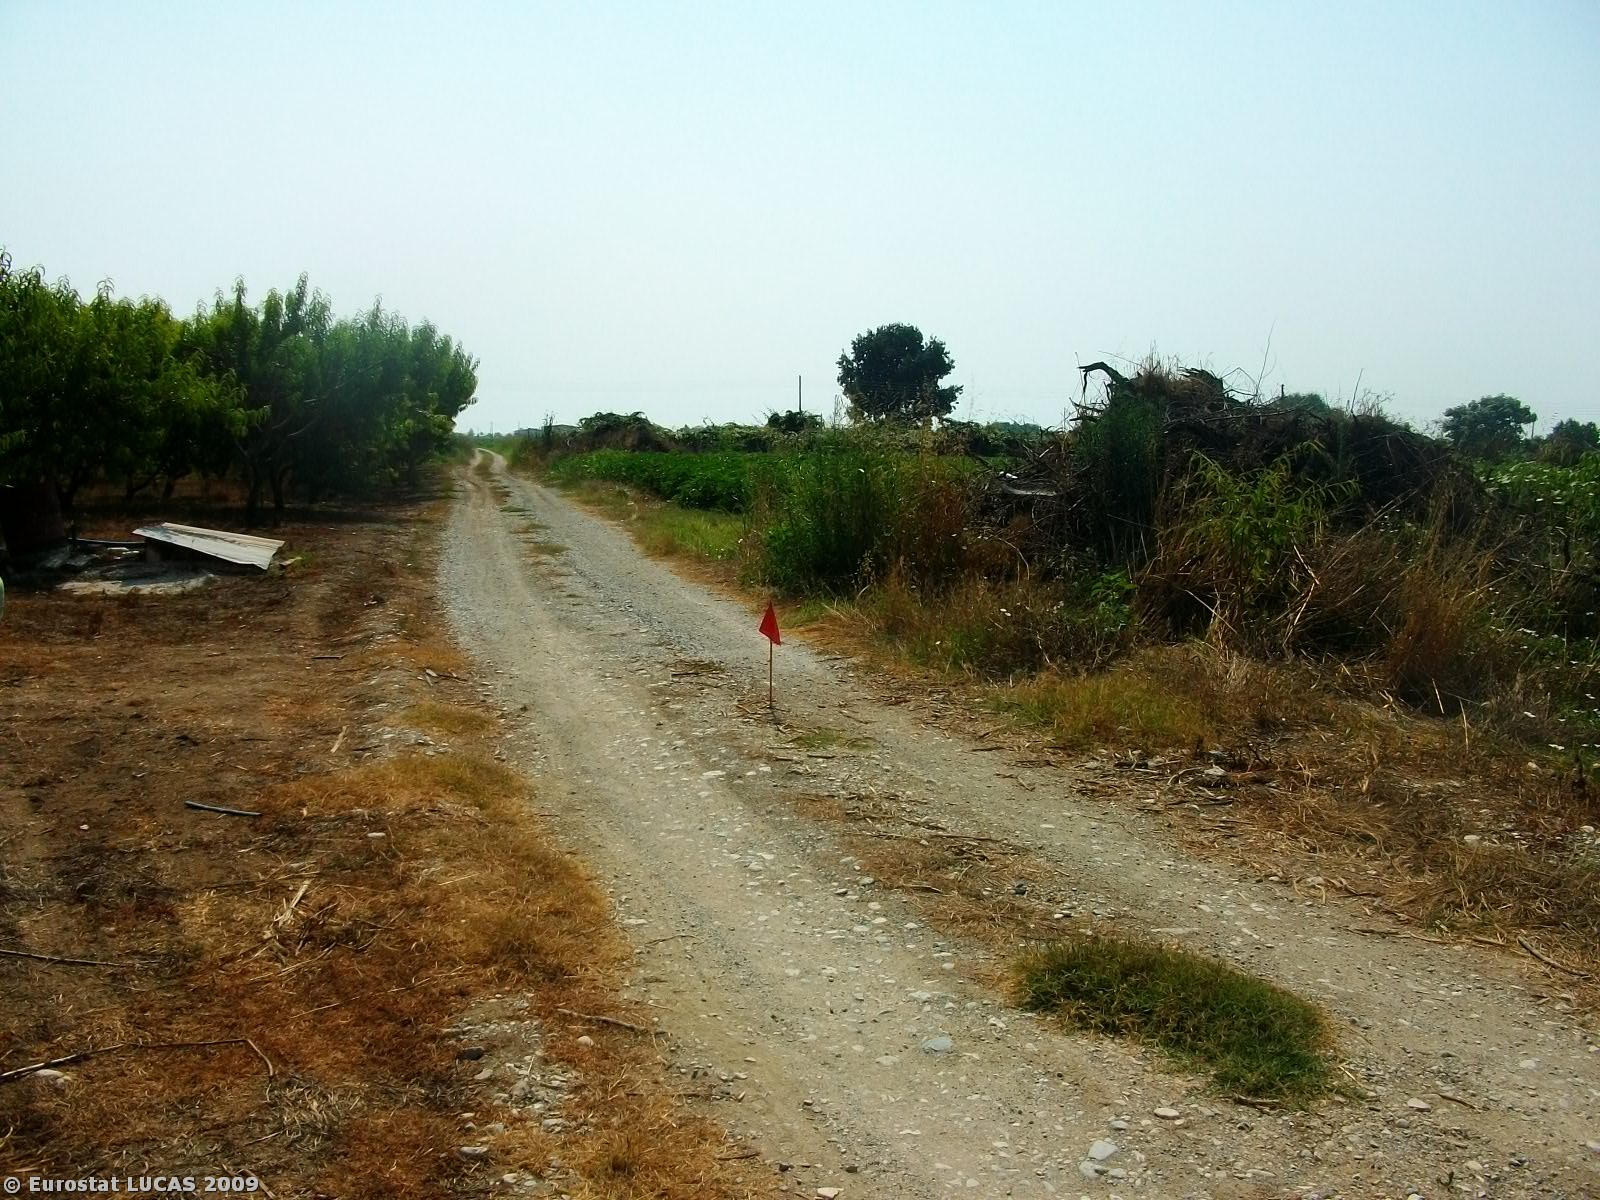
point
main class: Artificial land
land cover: Non built-up linear features
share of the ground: > 75 %
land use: Road transport
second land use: Agriculture (excluding fallow land and kitchen gardens)
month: July
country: GR
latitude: 40.2929
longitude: 22.5983
